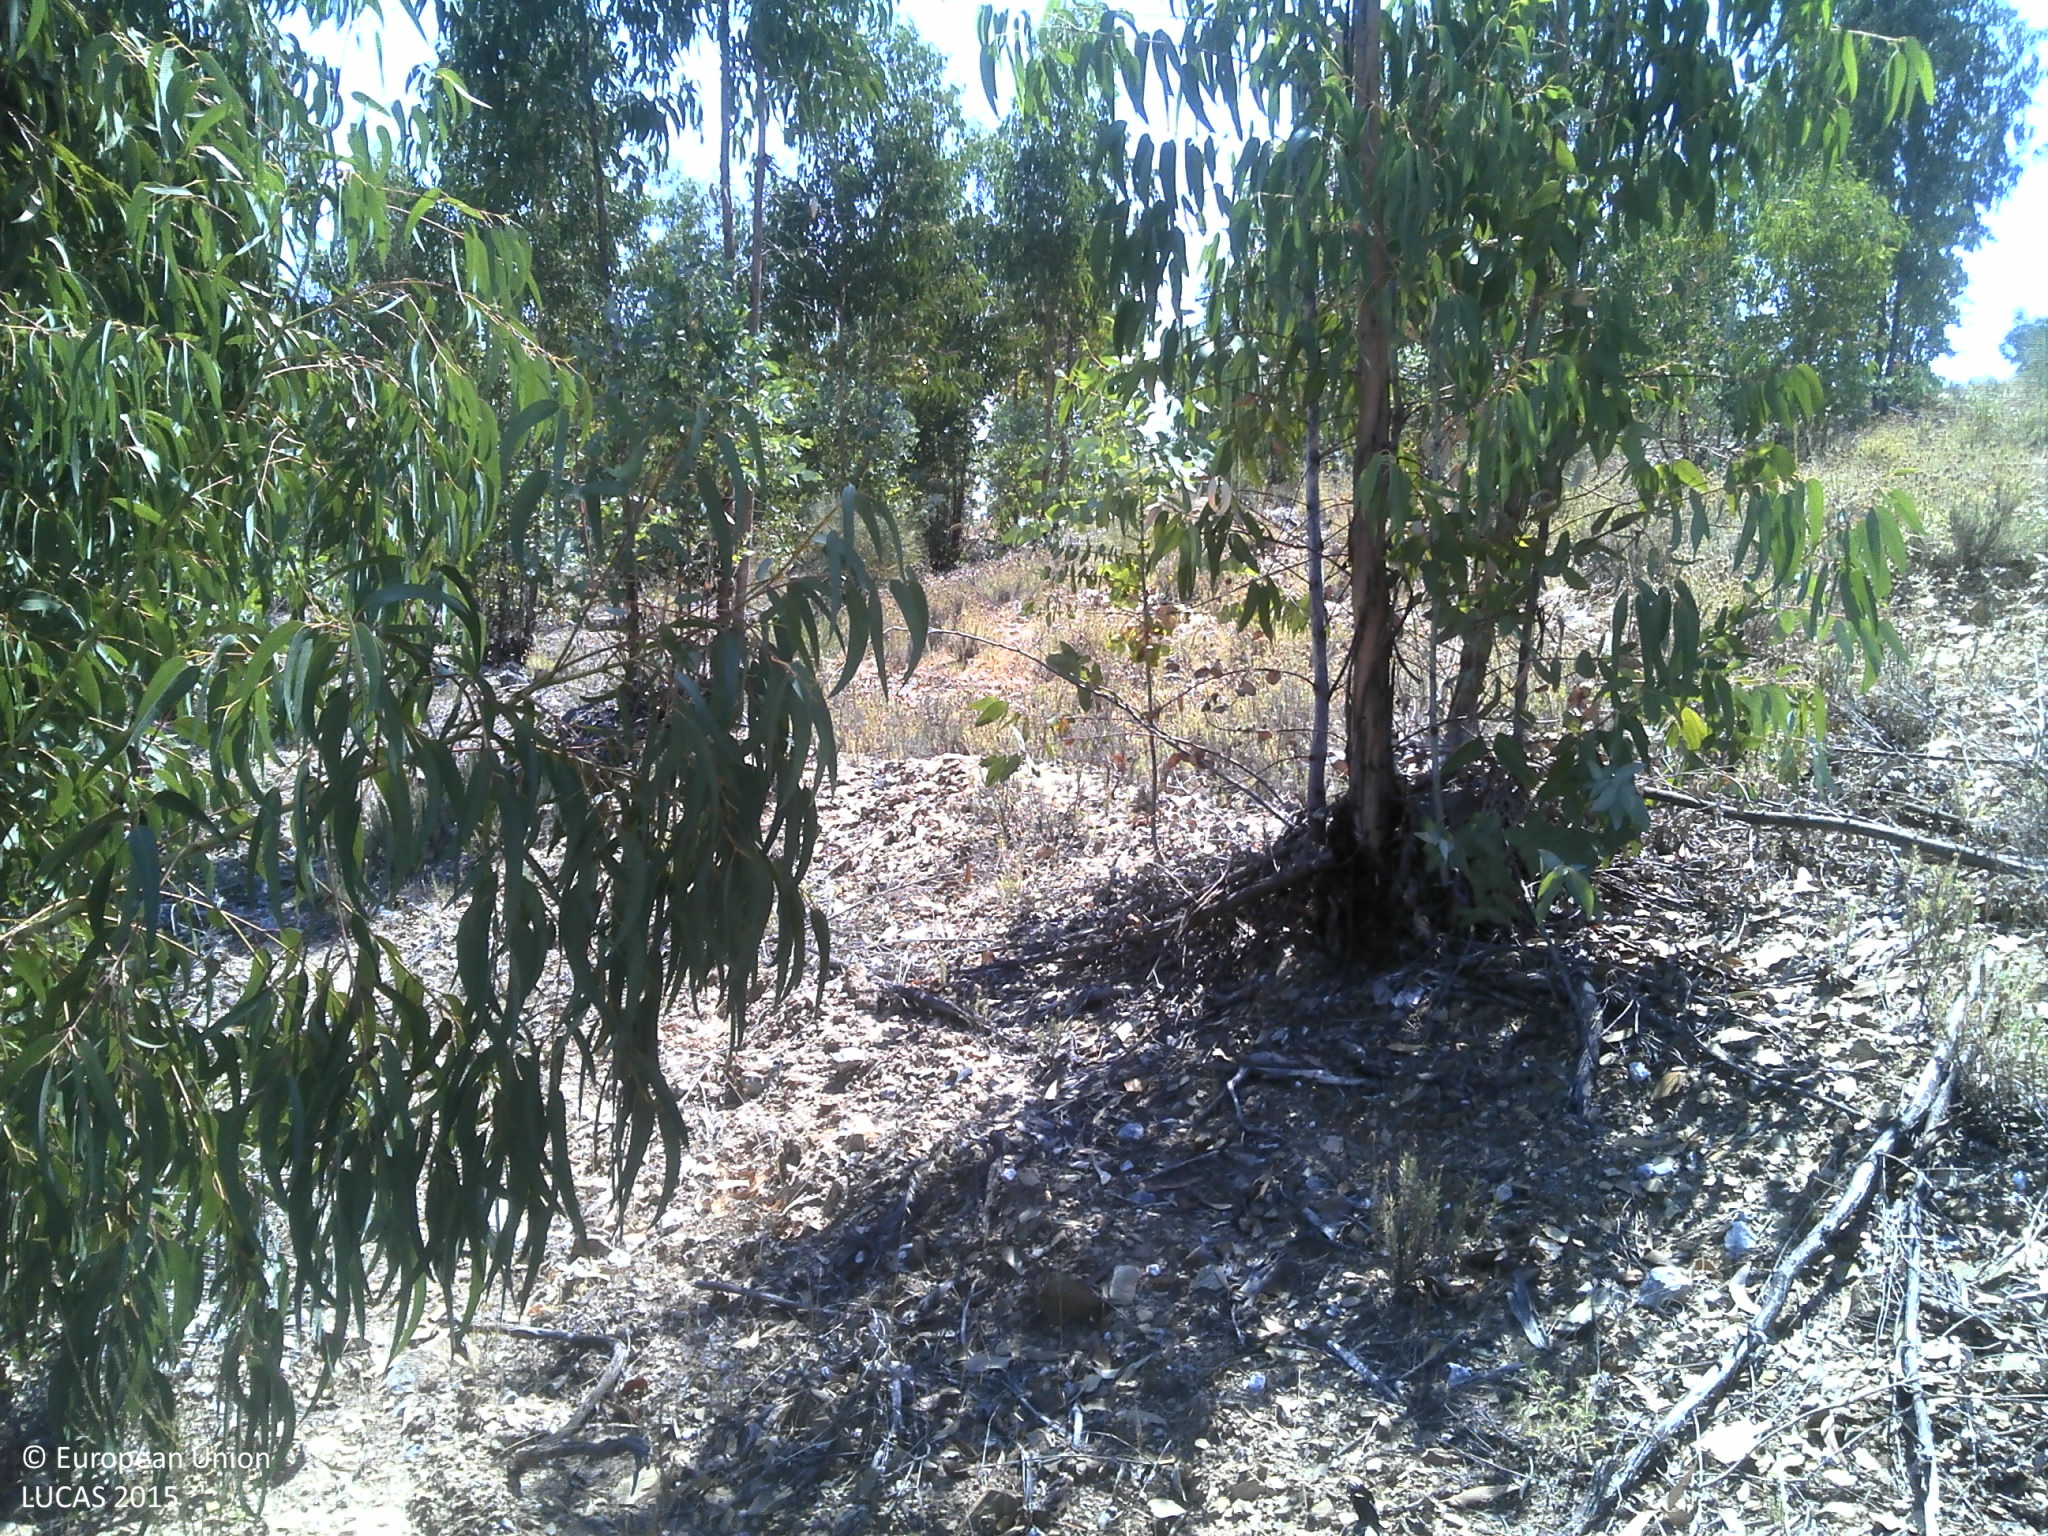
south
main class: Woodland
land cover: Broadleaved woodland
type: exotic forest
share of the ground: 25 - 50 %
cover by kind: broadleaved forest trees 50 %, unconsolidated bare surface 35 %, shrubs 15 %
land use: Forestry
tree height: > 5 m
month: June
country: PT
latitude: 39.7453
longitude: -7.0197
